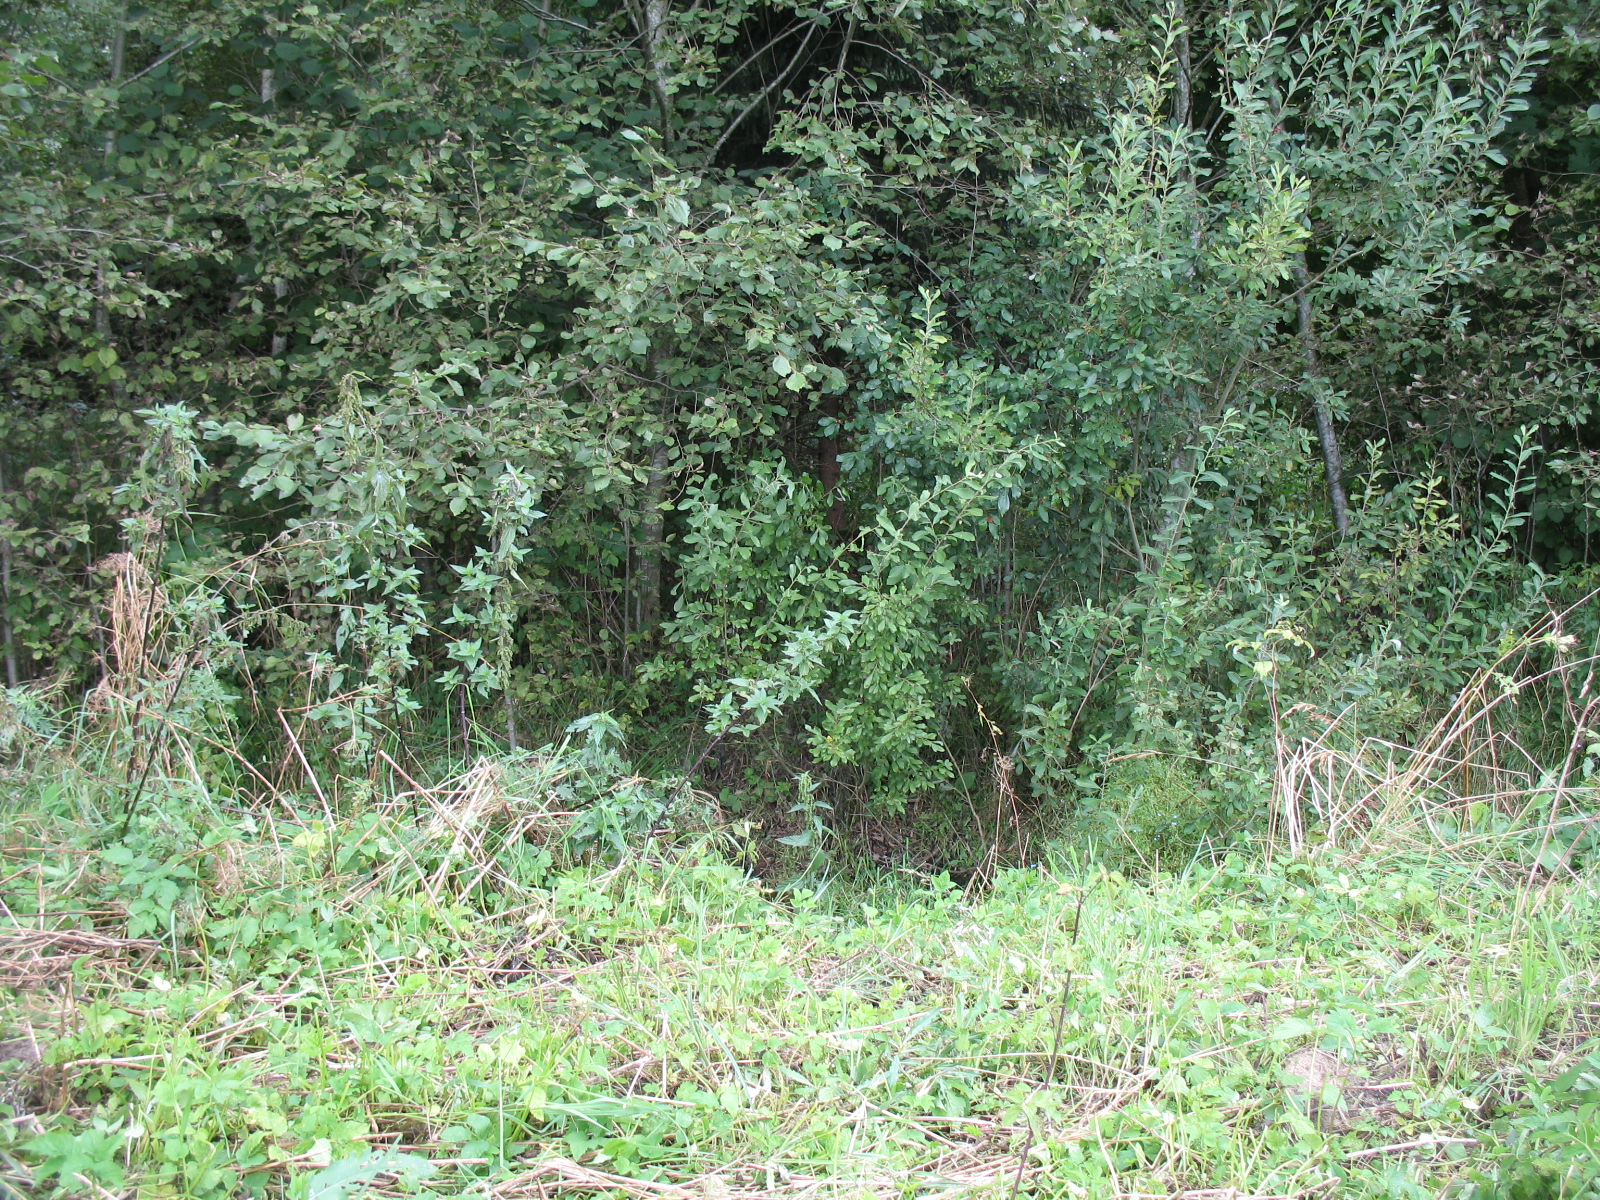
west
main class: Grassland
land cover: Grassland without tree/shrub cover
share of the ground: > 75 %
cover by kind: herbaceous plants 100 %
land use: Agriculture (excluding fallow land and kitchen gardens)
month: September
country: LV
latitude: 56.1182
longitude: 25.9443
